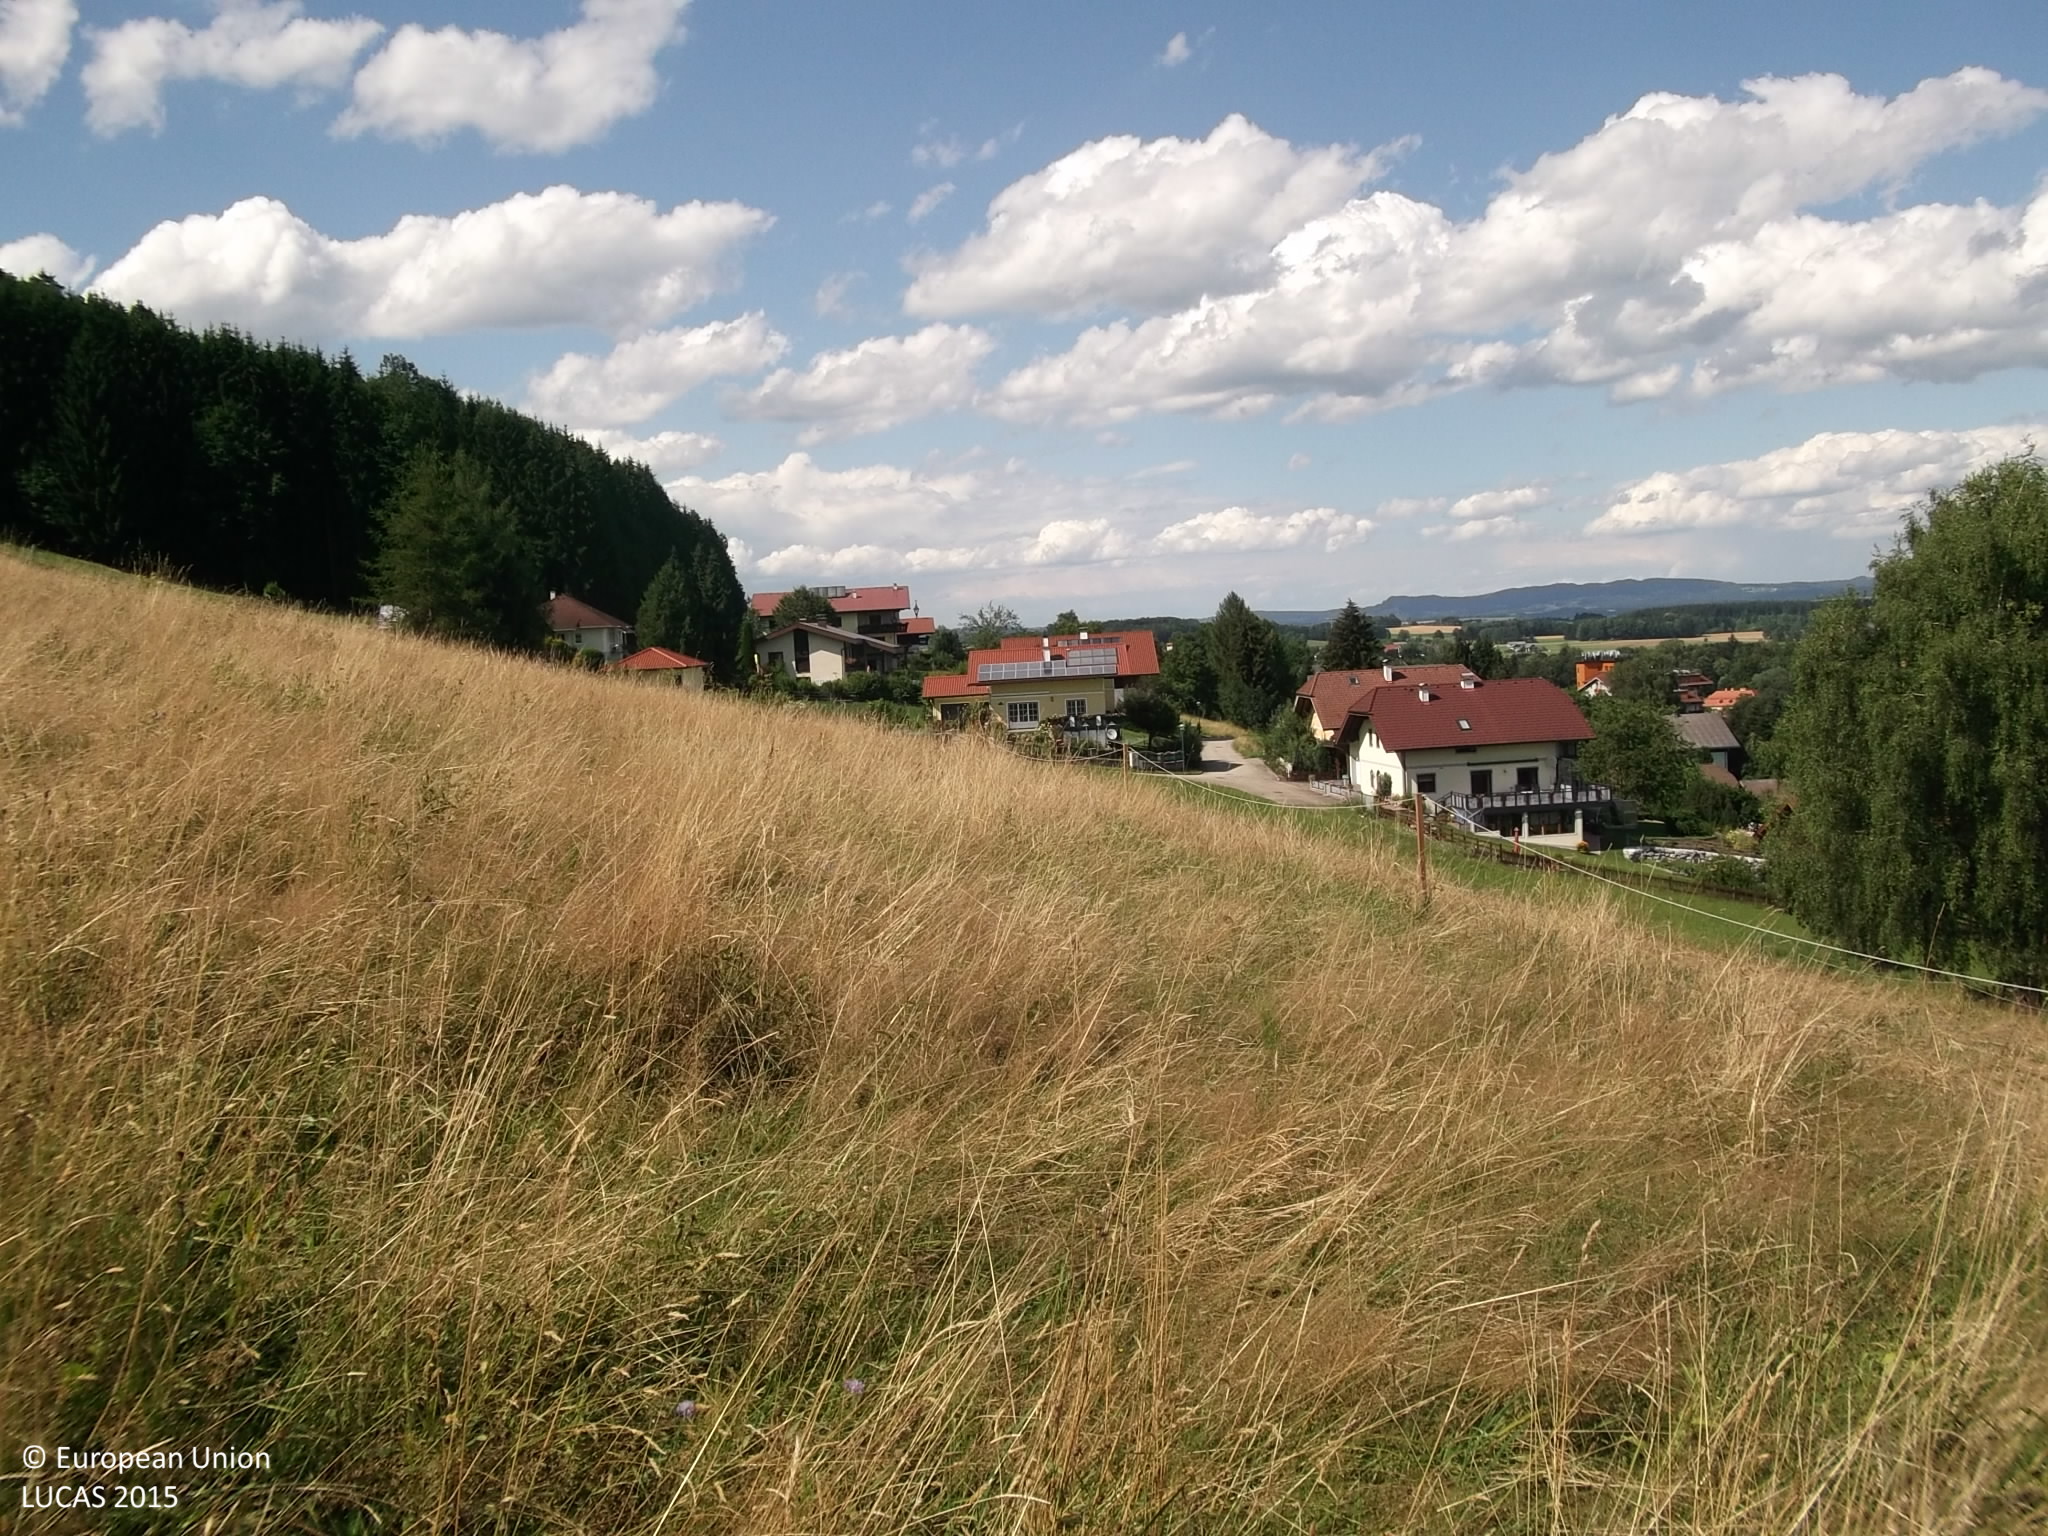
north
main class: Grassland
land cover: Grassland without tree/shrub cover
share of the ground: > 75 %
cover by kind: herbaceous plants 100 %
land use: Agriculture (excluding fallow land and kitchen gardens)
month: July
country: AT
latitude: 47.9349
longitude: 13.4659
